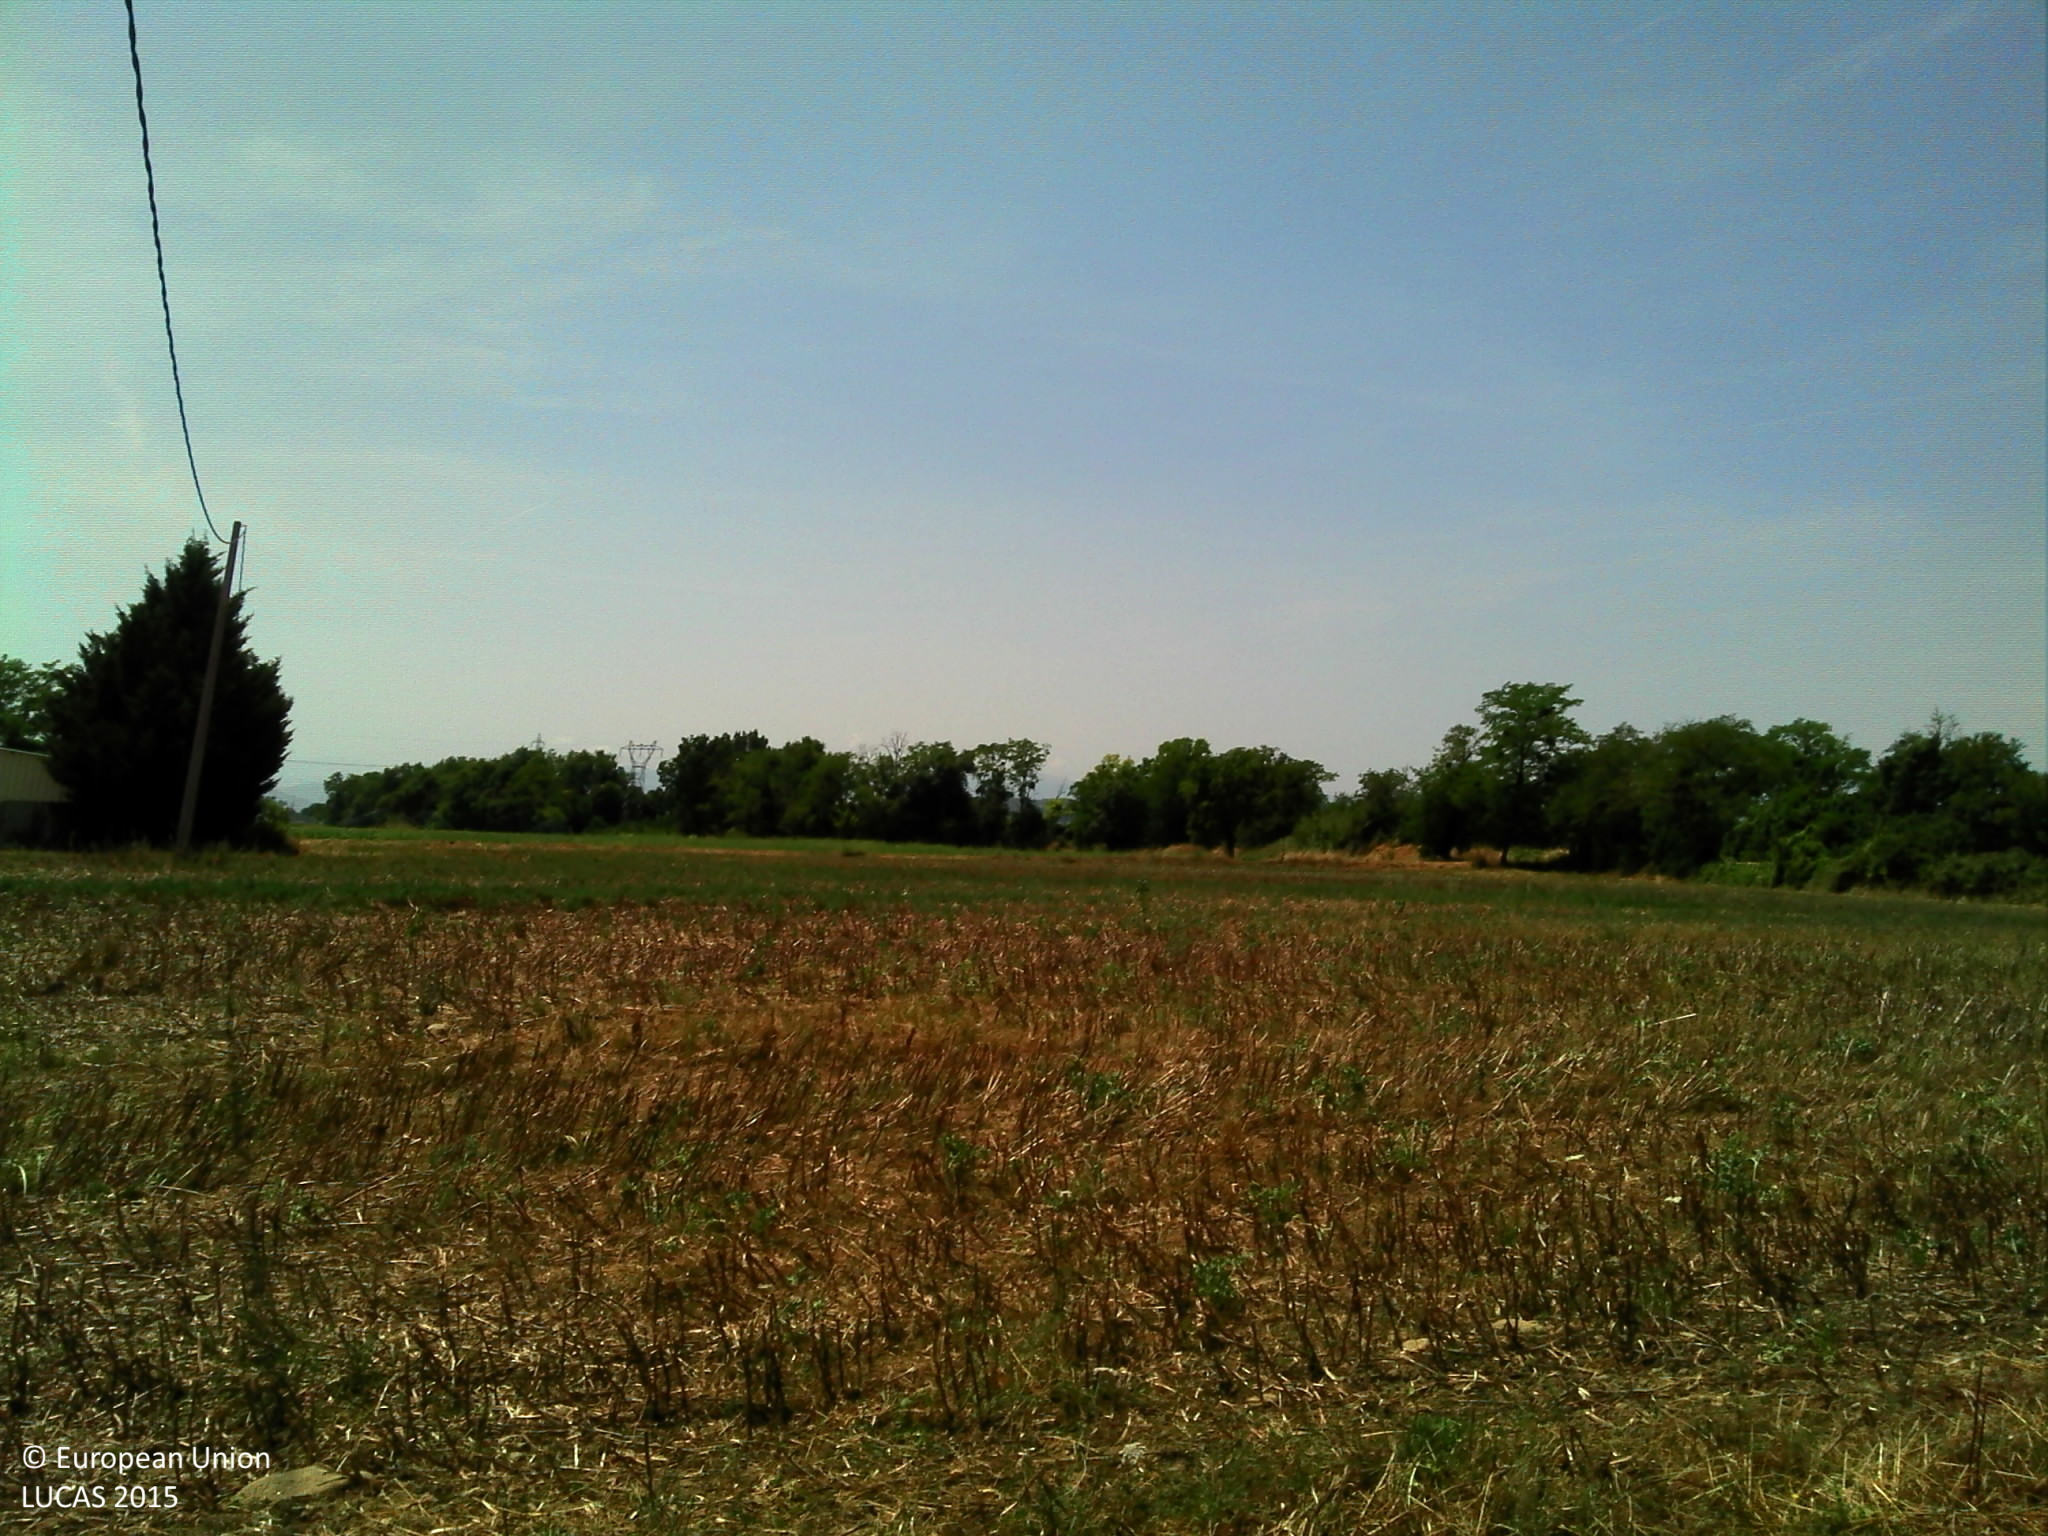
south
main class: Cropland
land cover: Common wheat
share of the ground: > 75 %
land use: Agriculture (excluding fallow land and kitchen gardens)
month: July
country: FR
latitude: 43.1419
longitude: 1.6331
